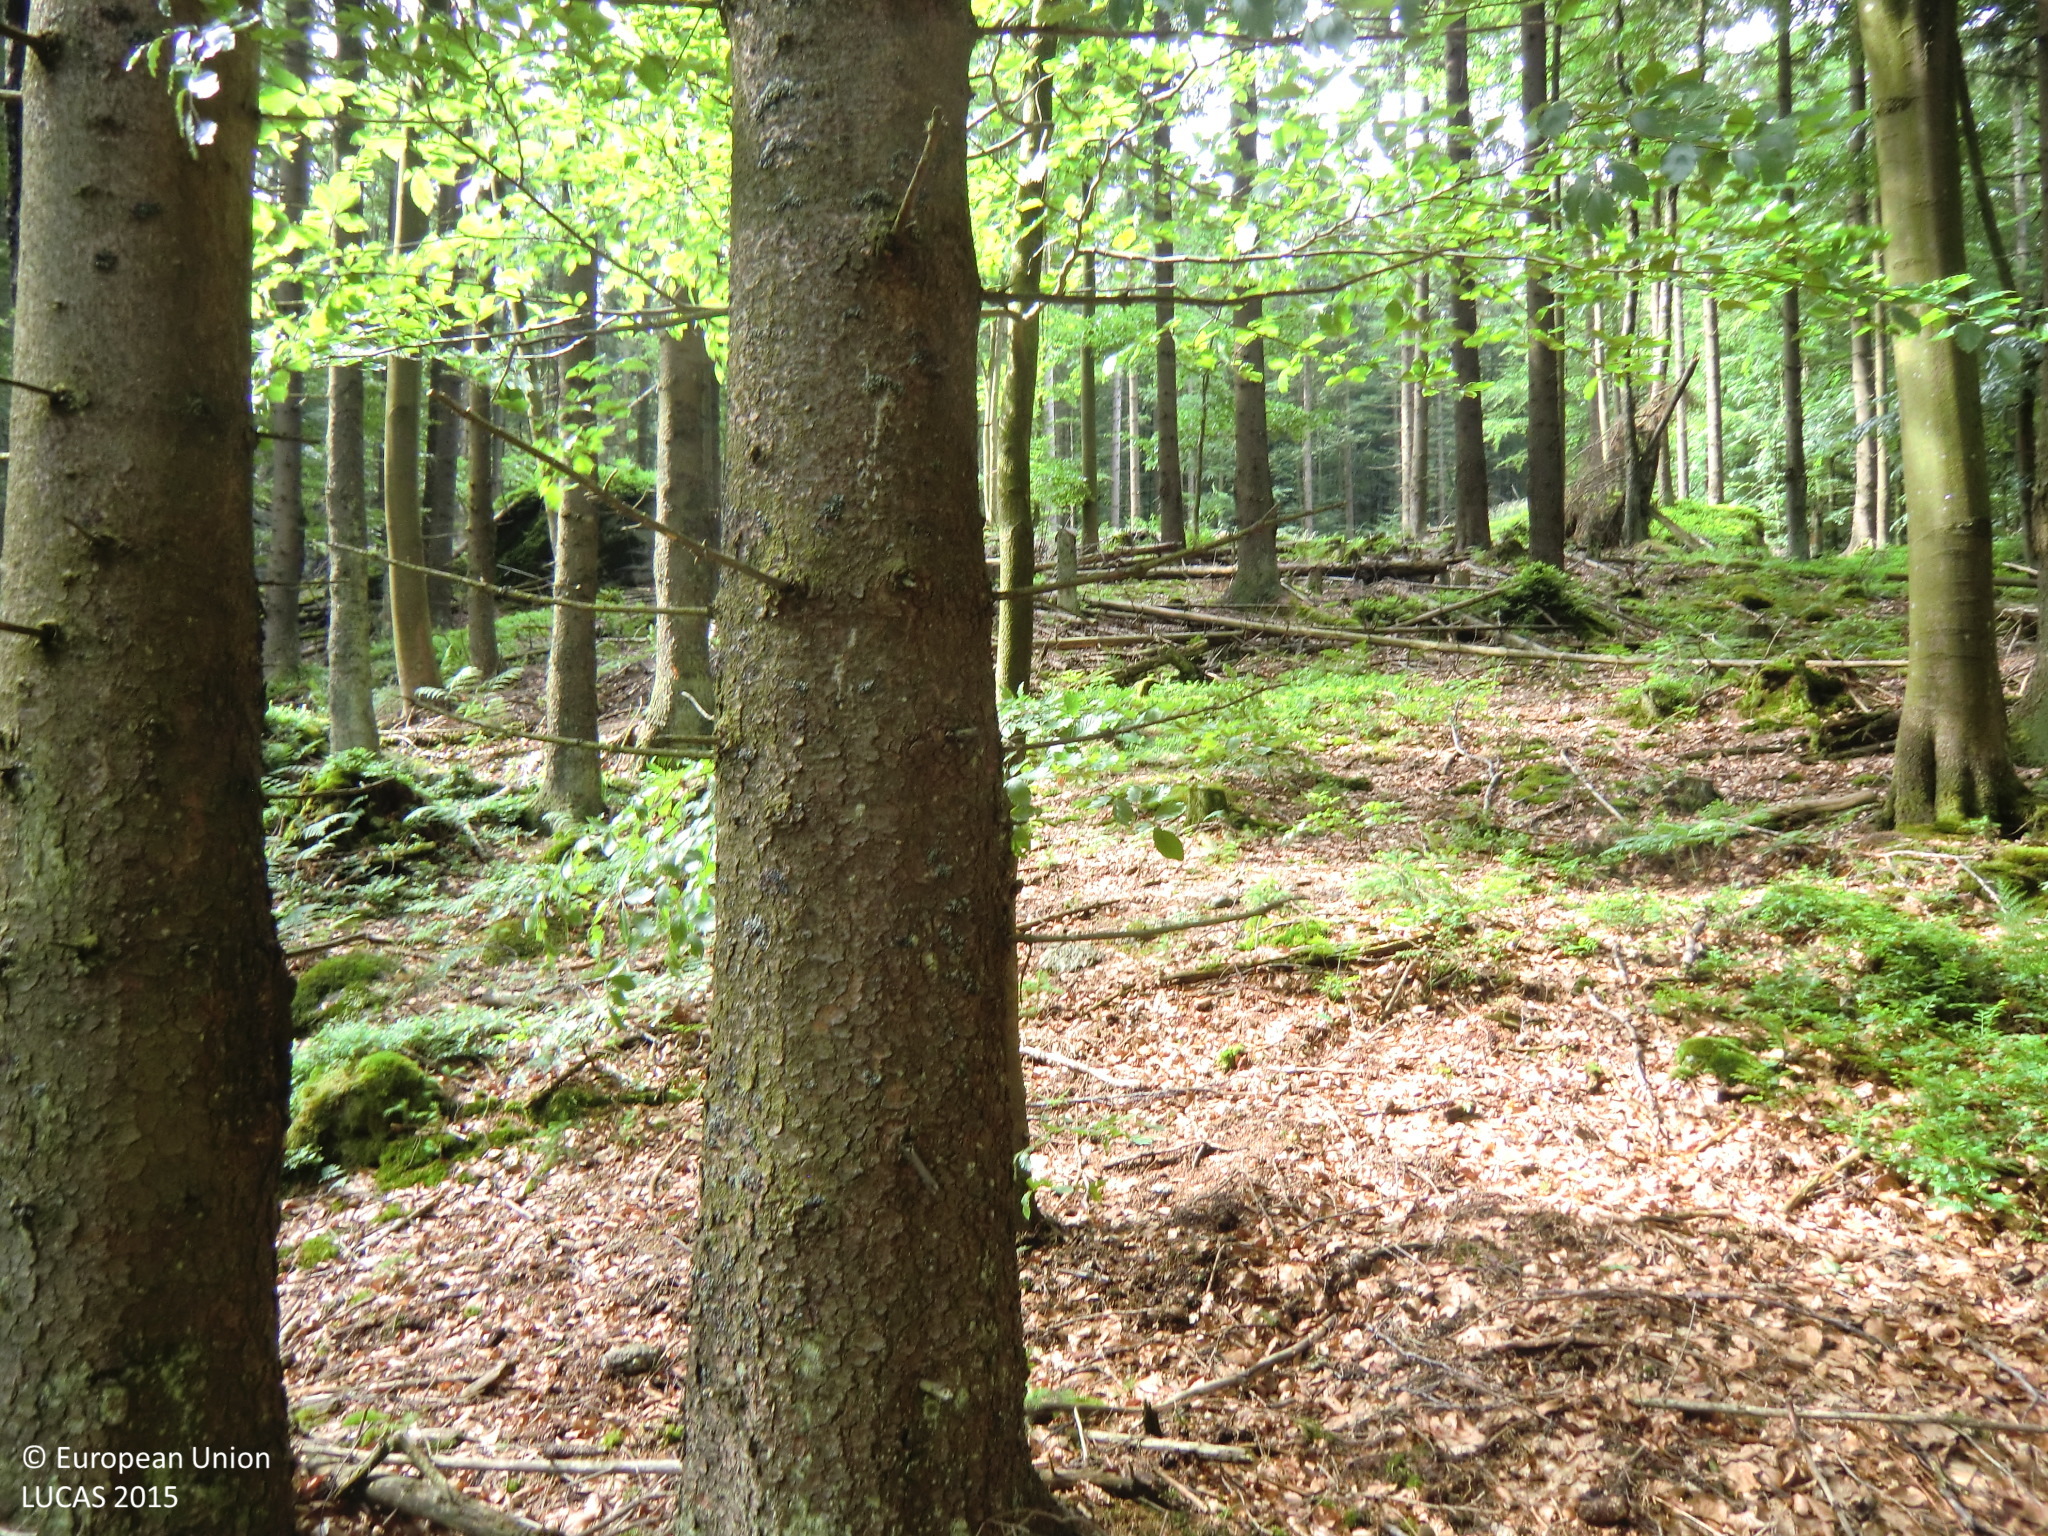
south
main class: Woodland
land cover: Spruce dominated mixed woodland
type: mountainous beech forest
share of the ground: > 75 %
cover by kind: coniferous forest trees 40 %, broadleaved forest trees 40 %, shrubs 10 %, herbaceous plants 5 %, unconsolidated bare surface 5 %
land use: Forestry
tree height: > 5 m
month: June
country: AT
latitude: 48.3250
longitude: 15.0322
